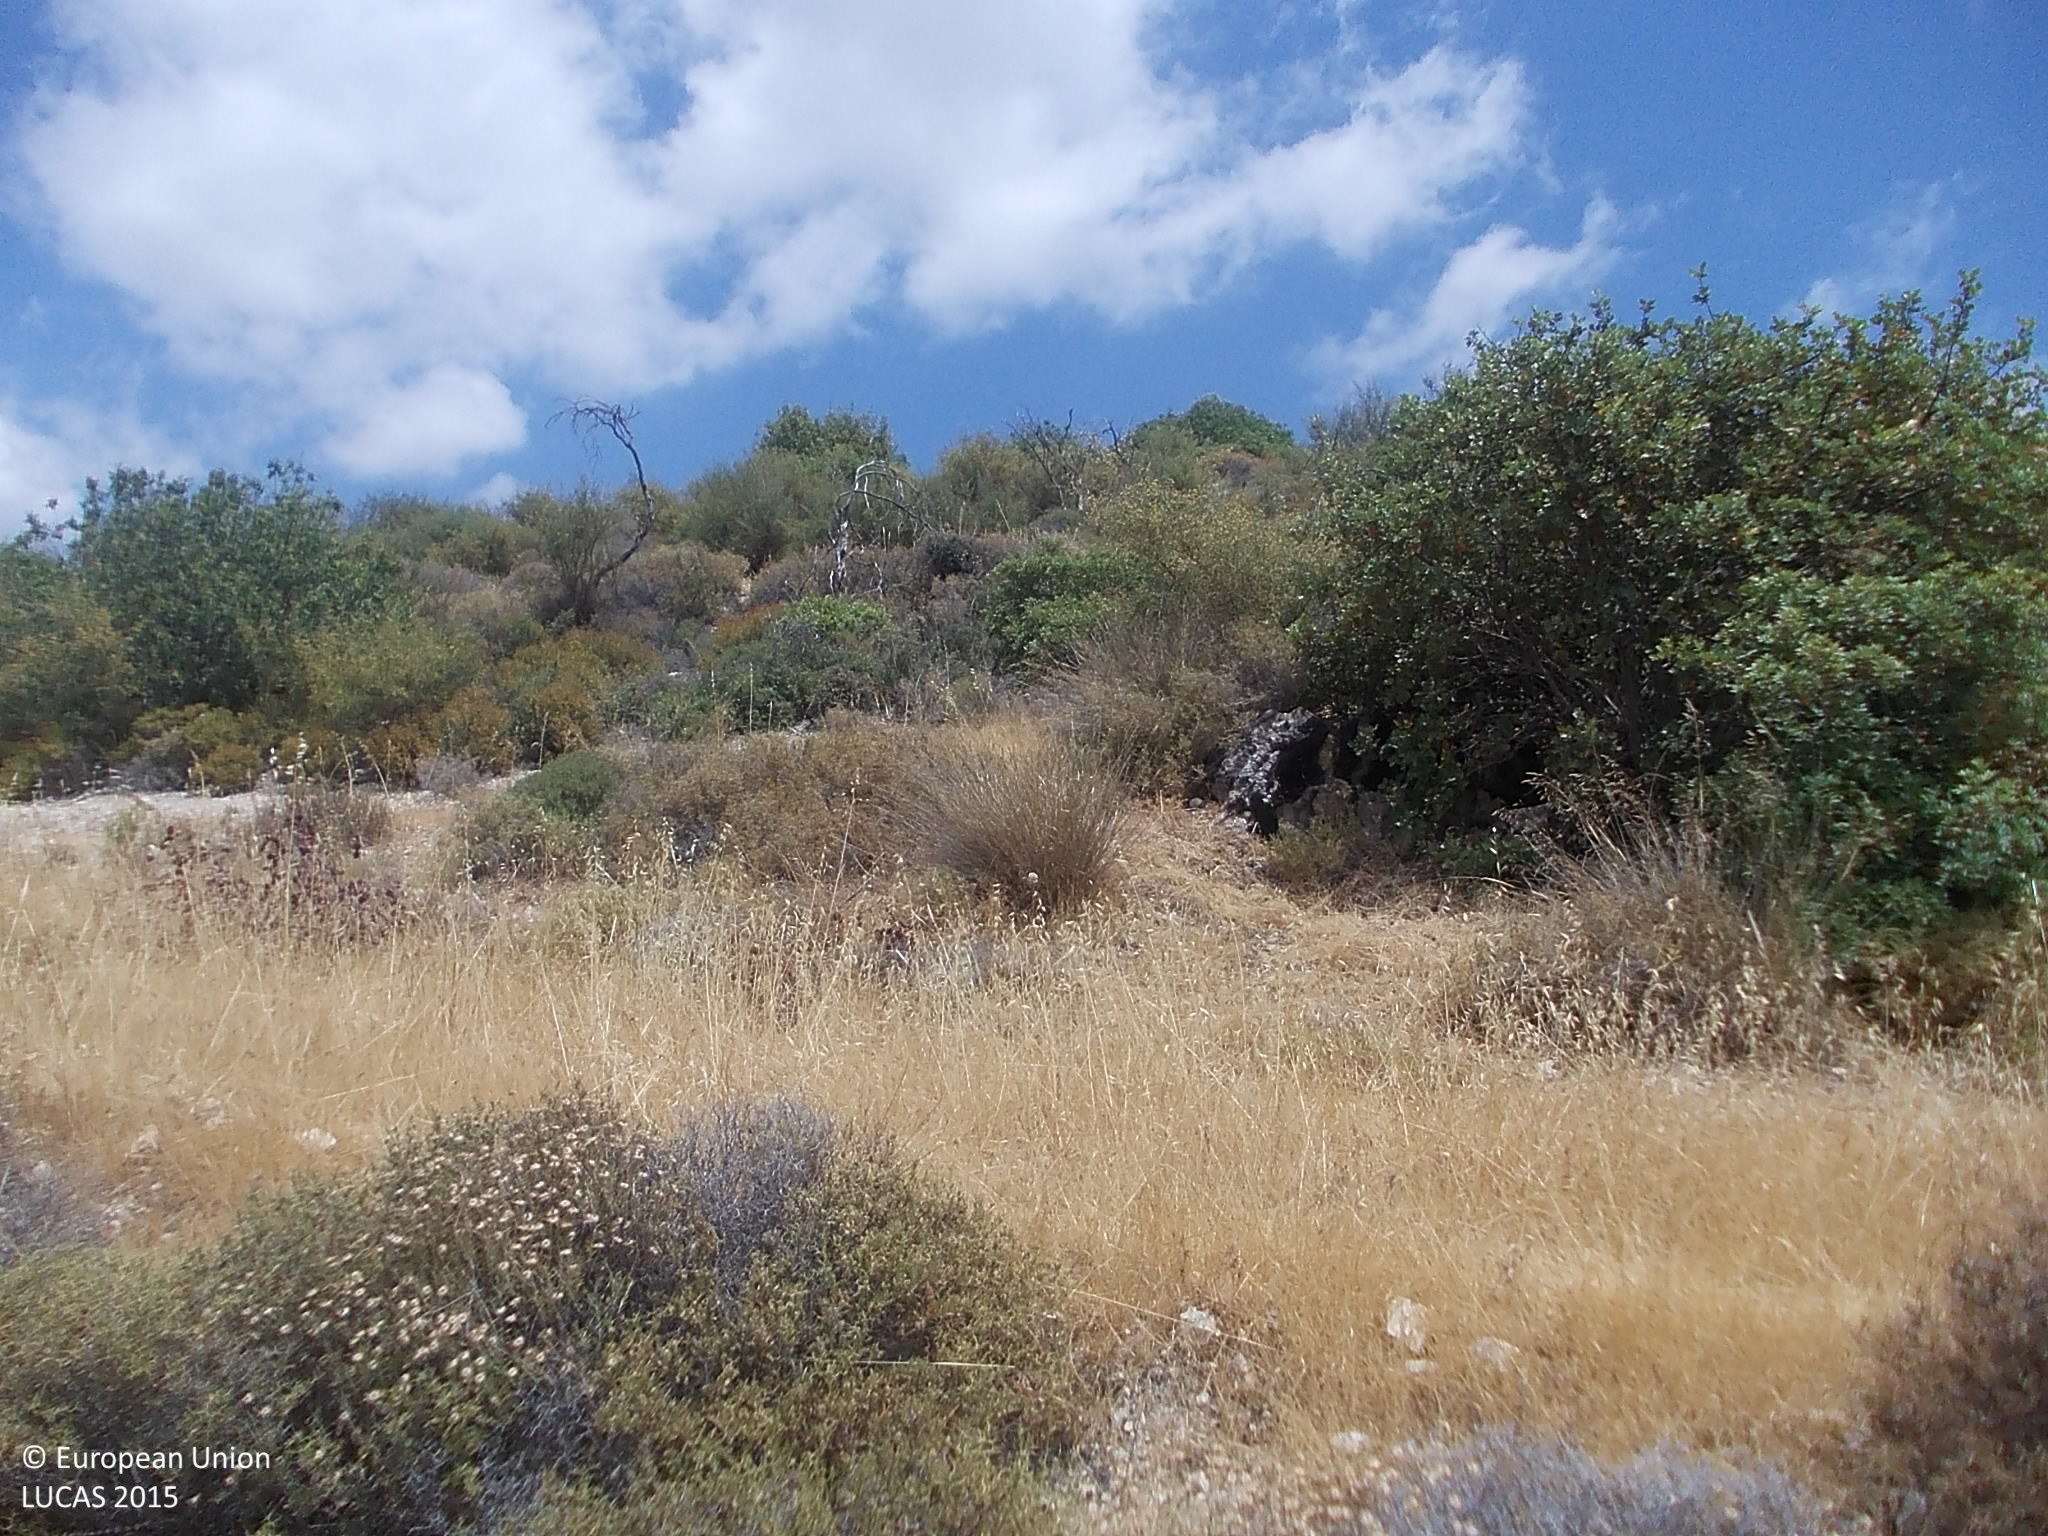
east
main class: Shrubland
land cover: Shrubland without tree cover
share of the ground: > 75 %
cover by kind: shrubs 80 %, herbaceous plants 10 %, unconsolidated bare surface 10 %
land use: Semi-natural and natural areas not in use
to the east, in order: Shrubland without tree cover; Grassland with sparse tree/shrub cover; Shrubland with sparse tree cover; Tracks; Permanent industrial crops; Tracks; Permanent industrial crops
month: June
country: CY
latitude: 34.7704
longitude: 32.9454
